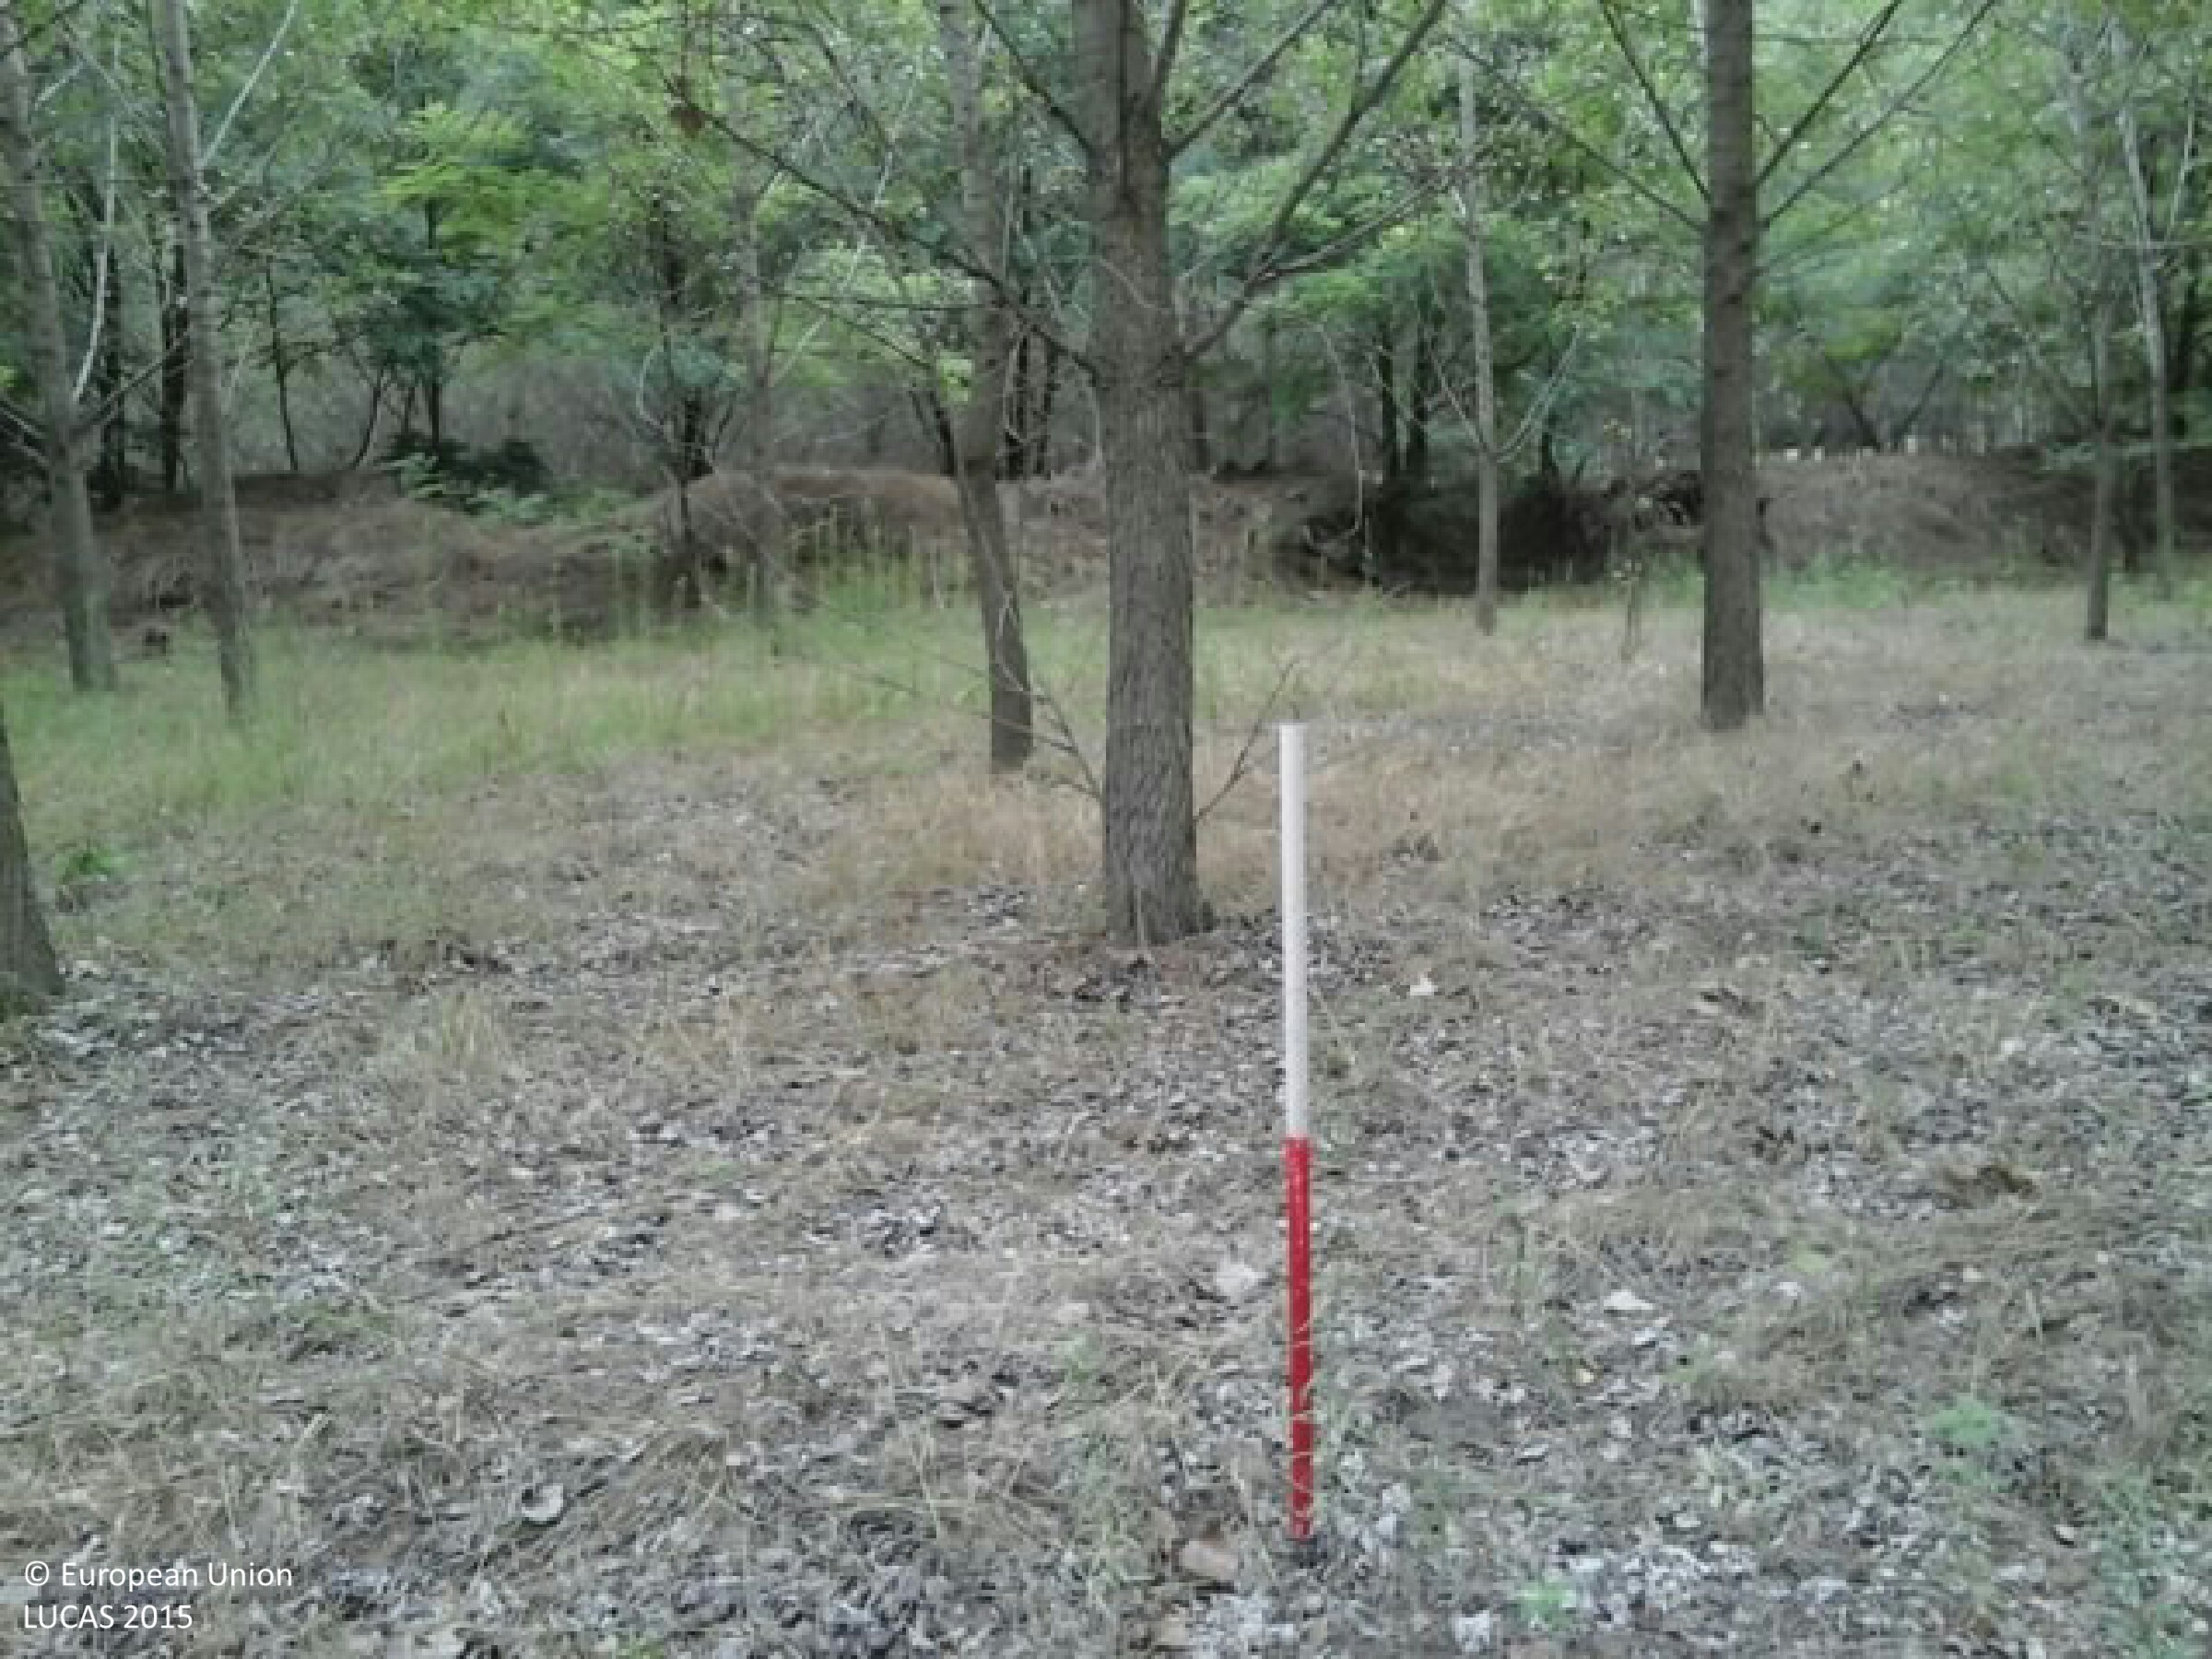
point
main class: Woodland
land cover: Broadleaved woodland
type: mesophytic deciduous forest
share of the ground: > 75 %
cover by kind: broadleaved forest trees 80 %, herbaceous plants 20 %
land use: Forestry
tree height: > 5 m
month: July
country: HU
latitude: 47.1257
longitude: 19.6840
